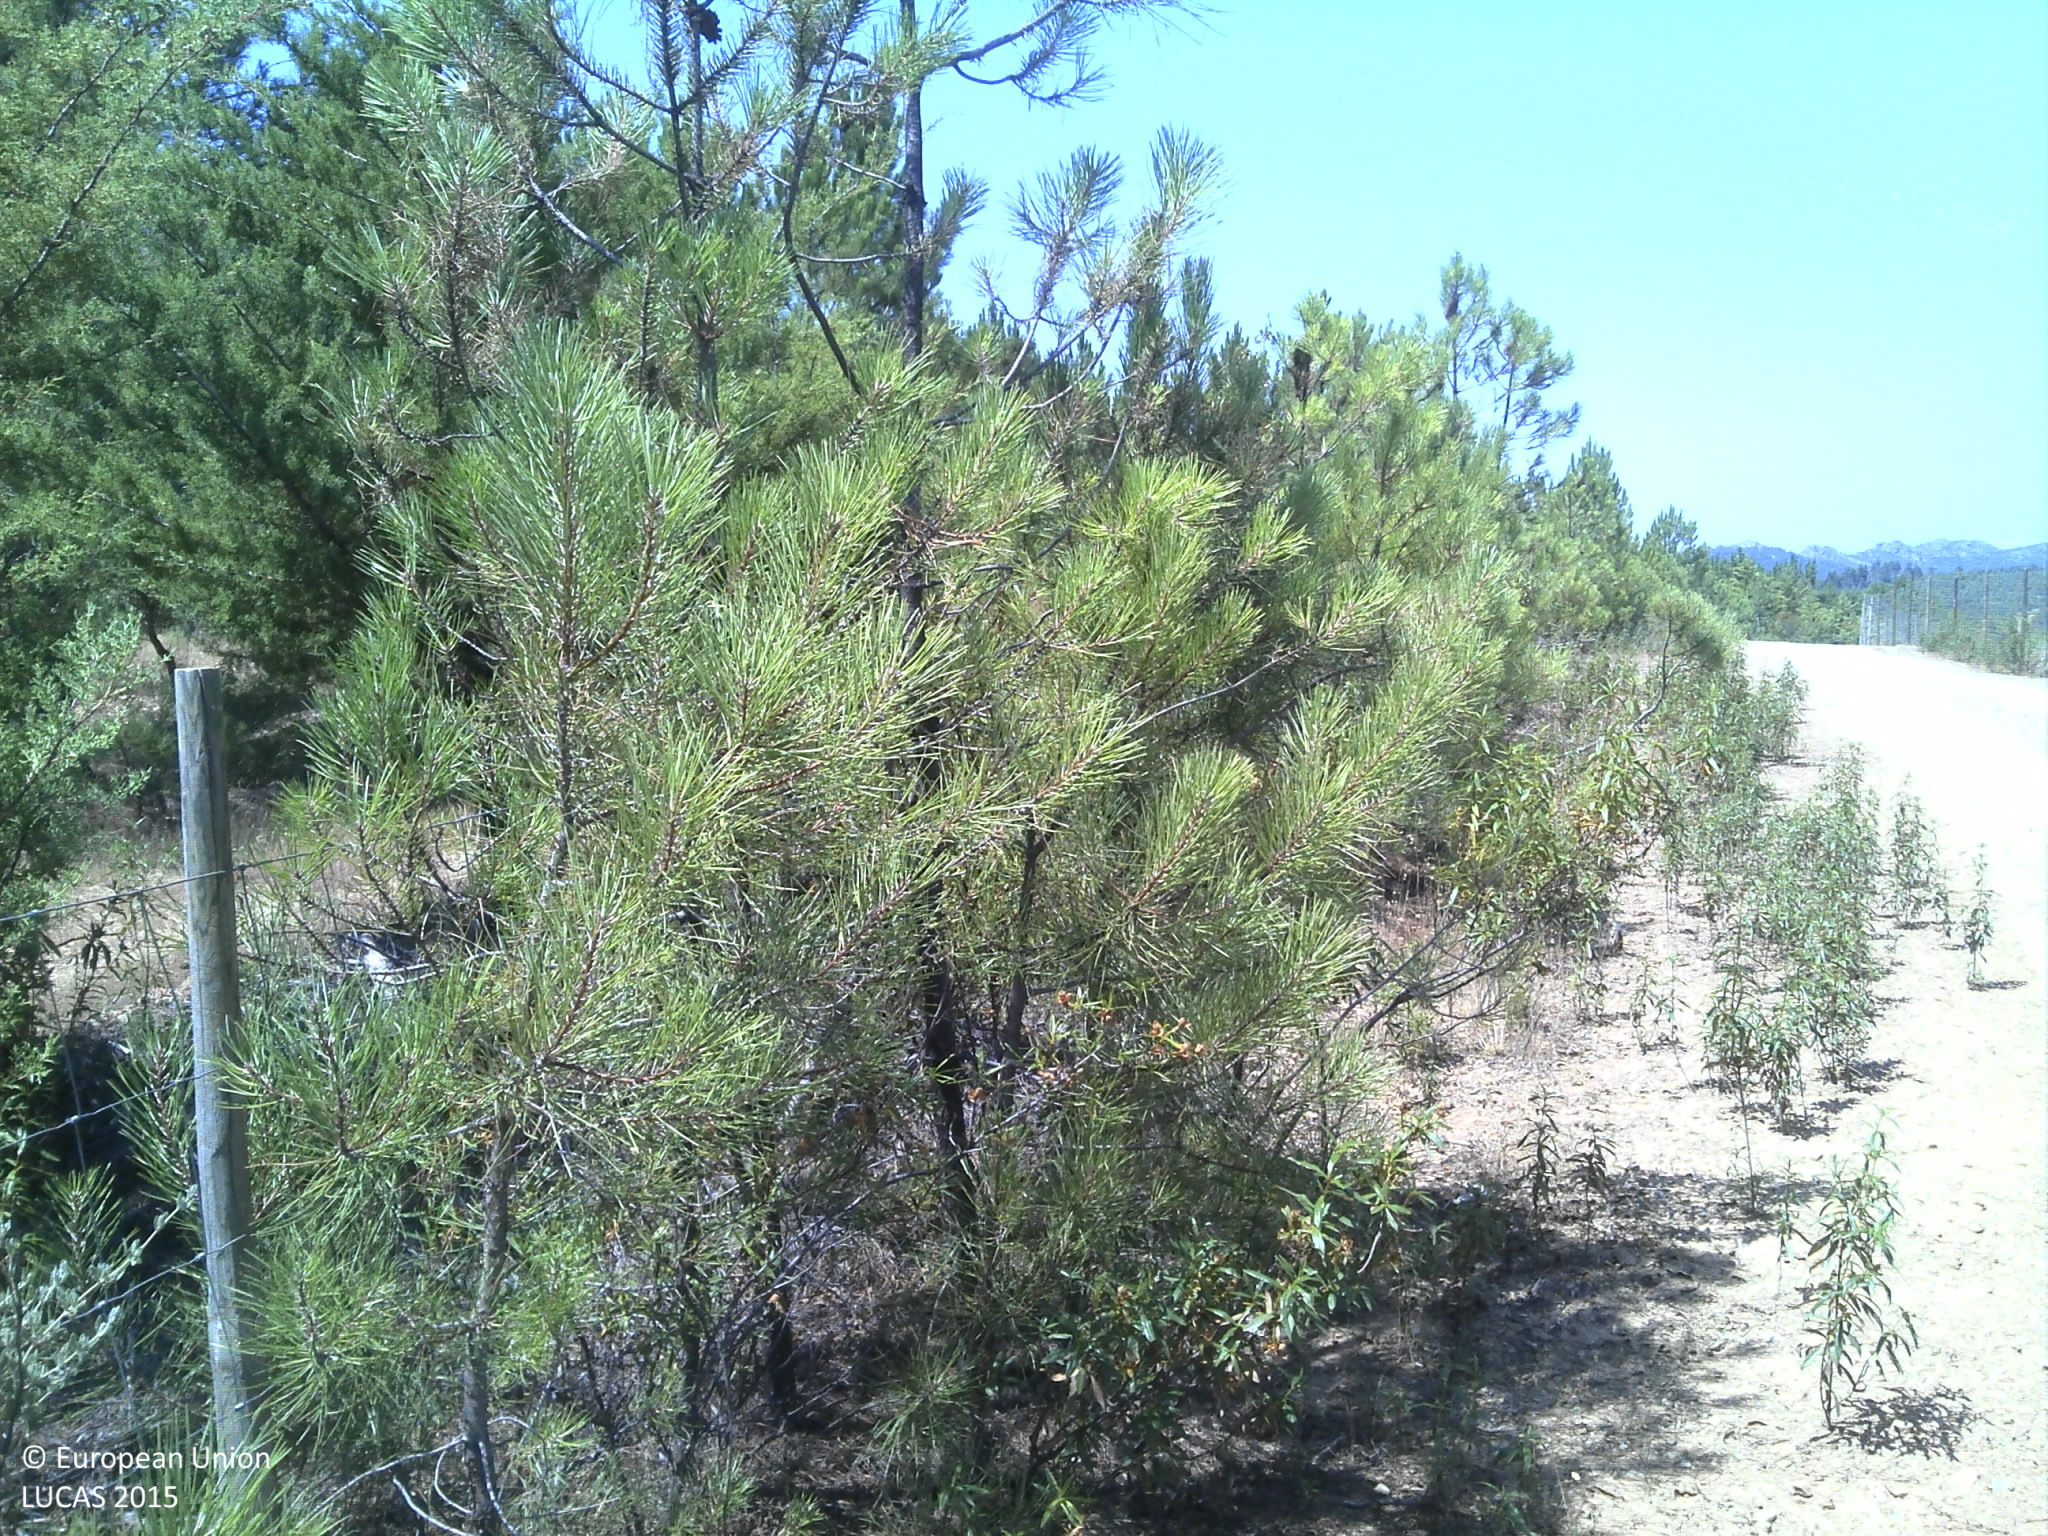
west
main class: Woodland
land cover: Pine dominated coniferous woodland
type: coniferous forest of the mediterranean region
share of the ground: > 75 %
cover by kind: coniferous forest trees 75 %, unconsolidated bare surface 25 %
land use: Forestry
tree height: > 5 m
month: June
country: PT
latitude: 40.0781
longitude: -7.0137
